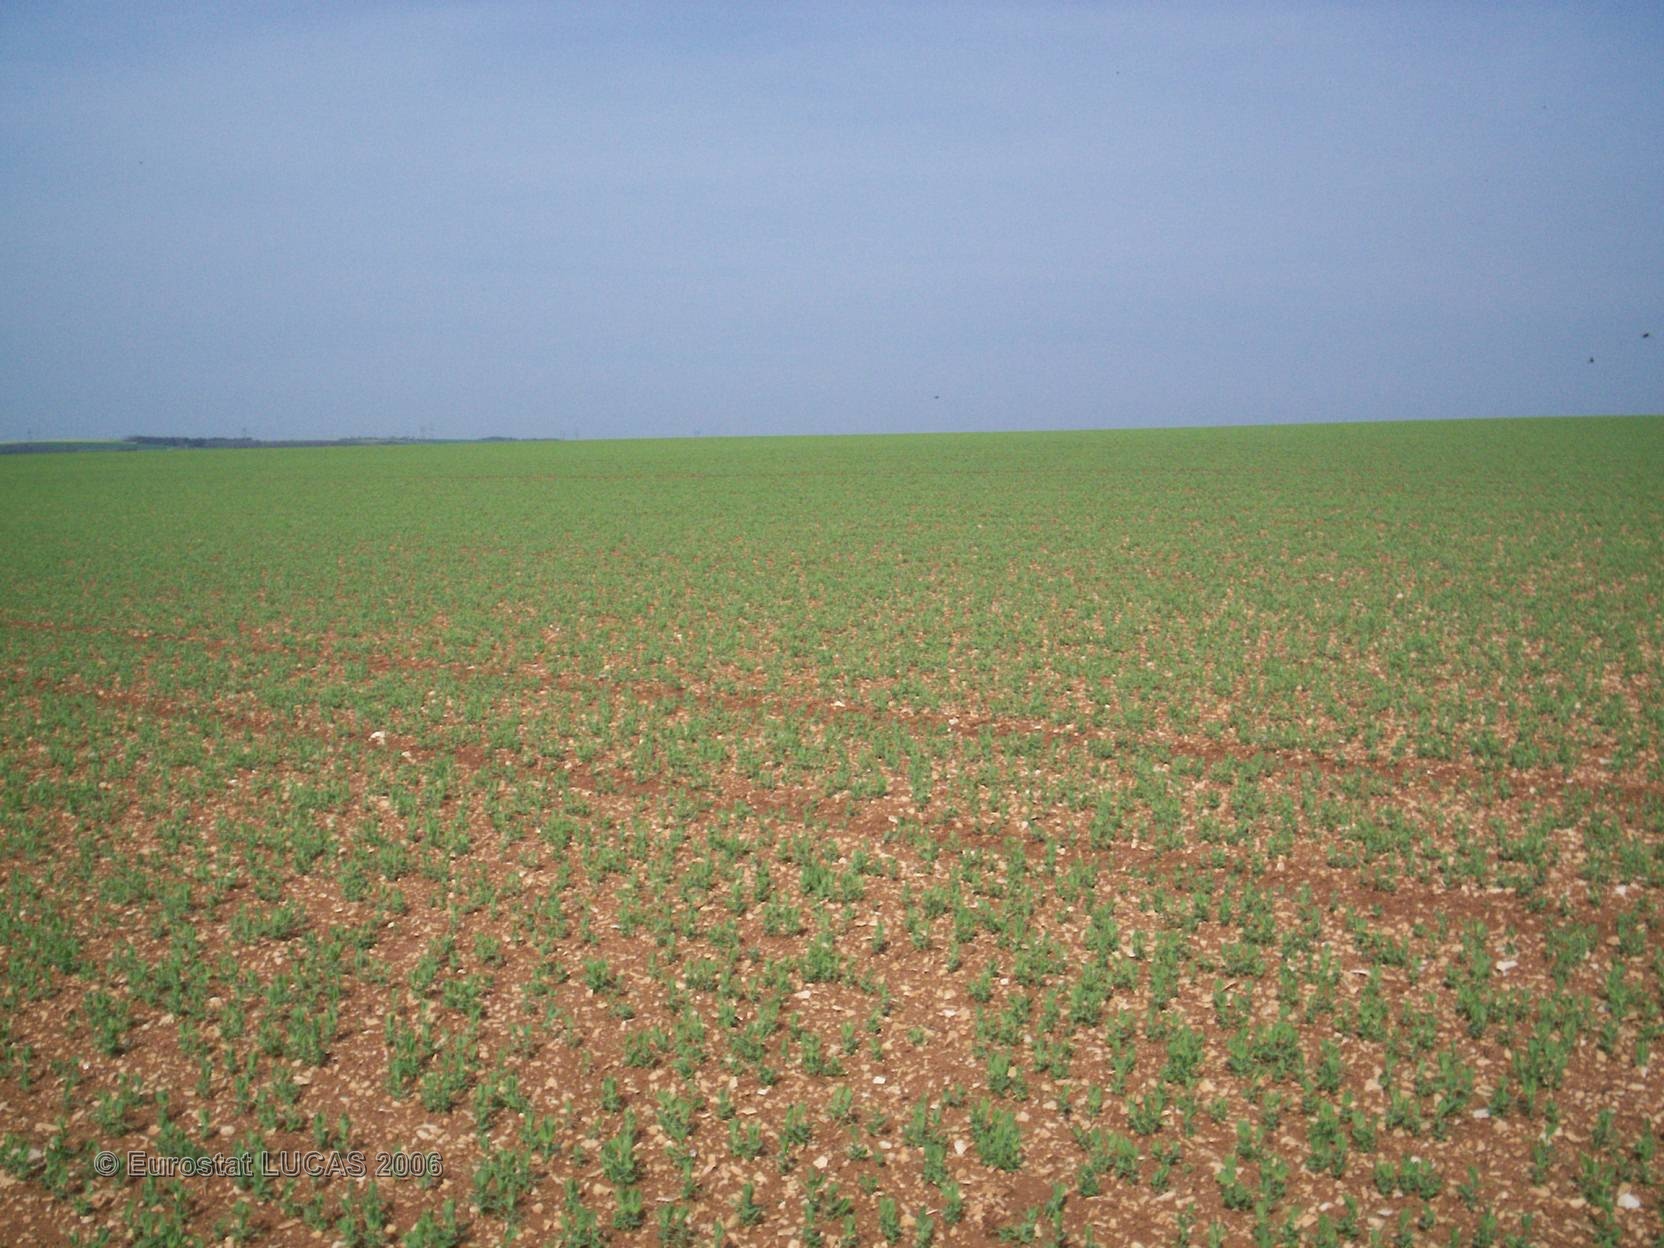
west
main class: Cropland
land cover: Dry pulses
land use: Agriculture (excluding fallow land and kitchen gardens)
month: May
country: FR
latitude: 47.6228
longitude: 4.6101
